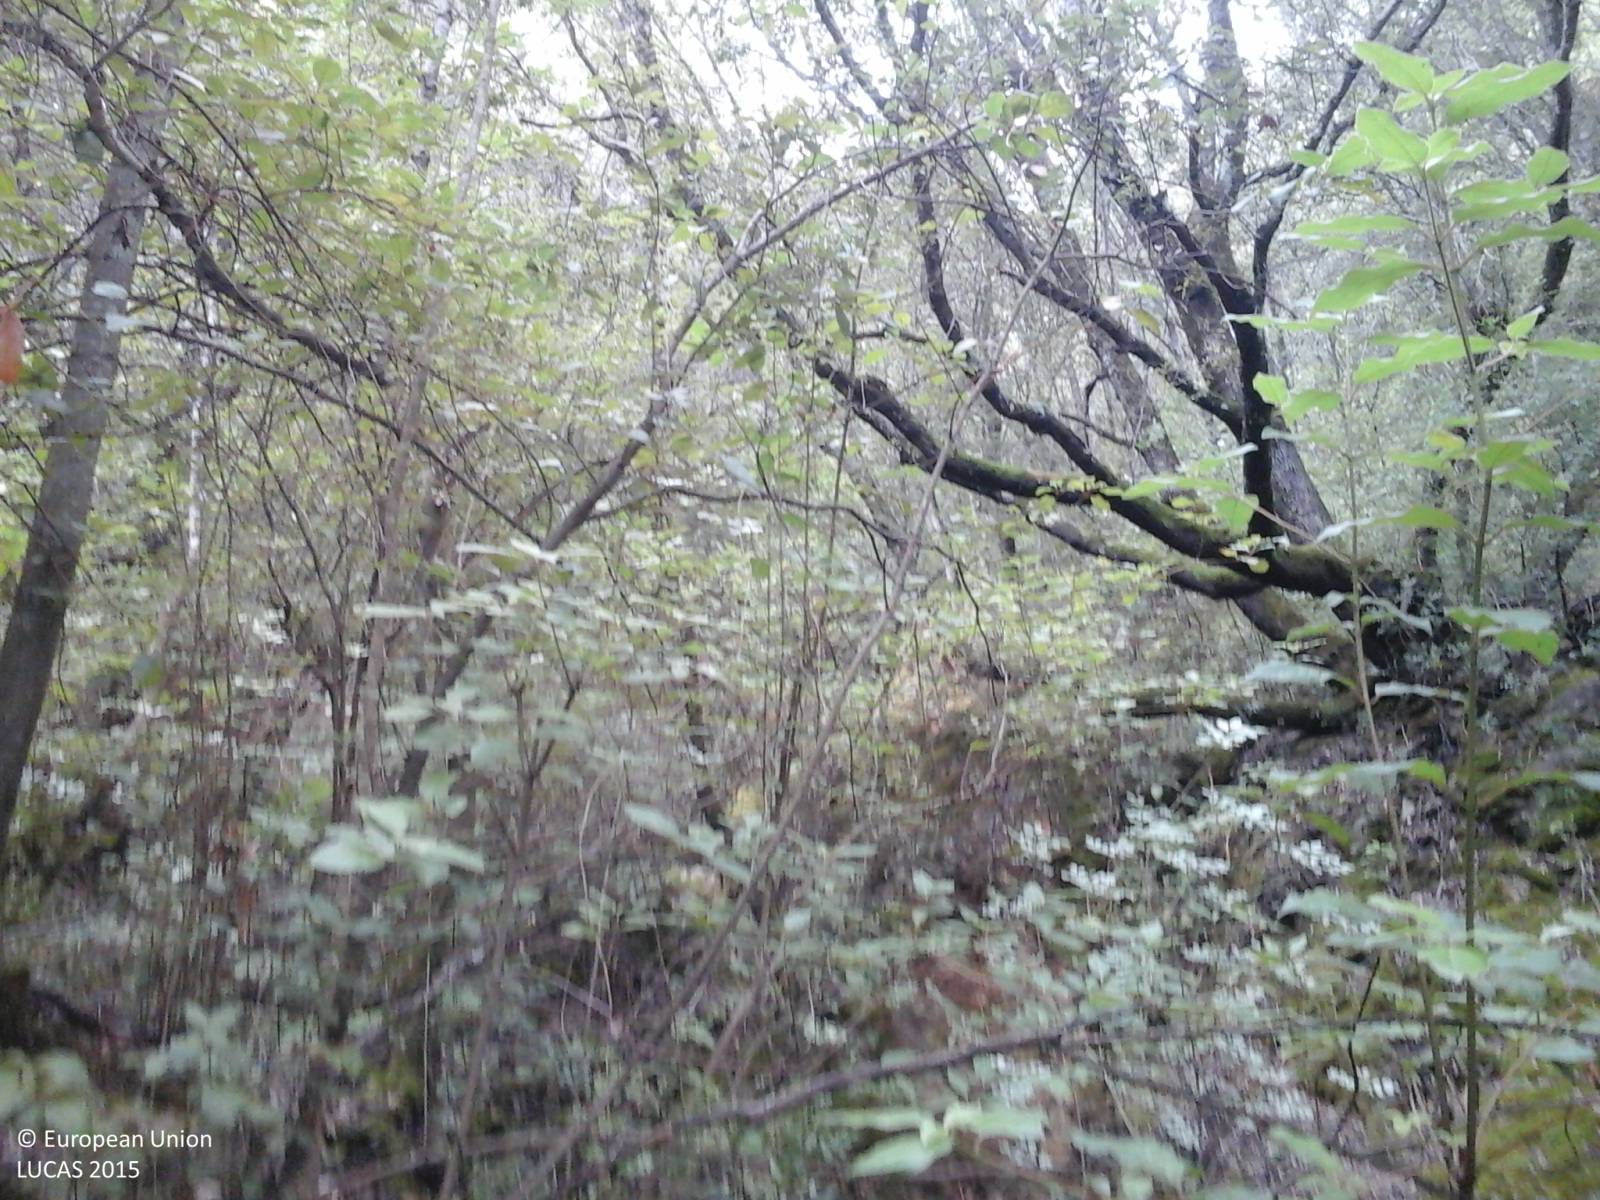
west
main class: Woodland
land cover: Broadleaved woodland
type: broadleaved evergreen forest
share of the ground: > 75 %
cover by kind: broadleaved forest trees 80 %, shrubs 20 %
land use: Semi-natural and natural areas not in use
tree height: > 5 m
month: September
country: IT
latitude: 39.7413
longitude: 9.5707
